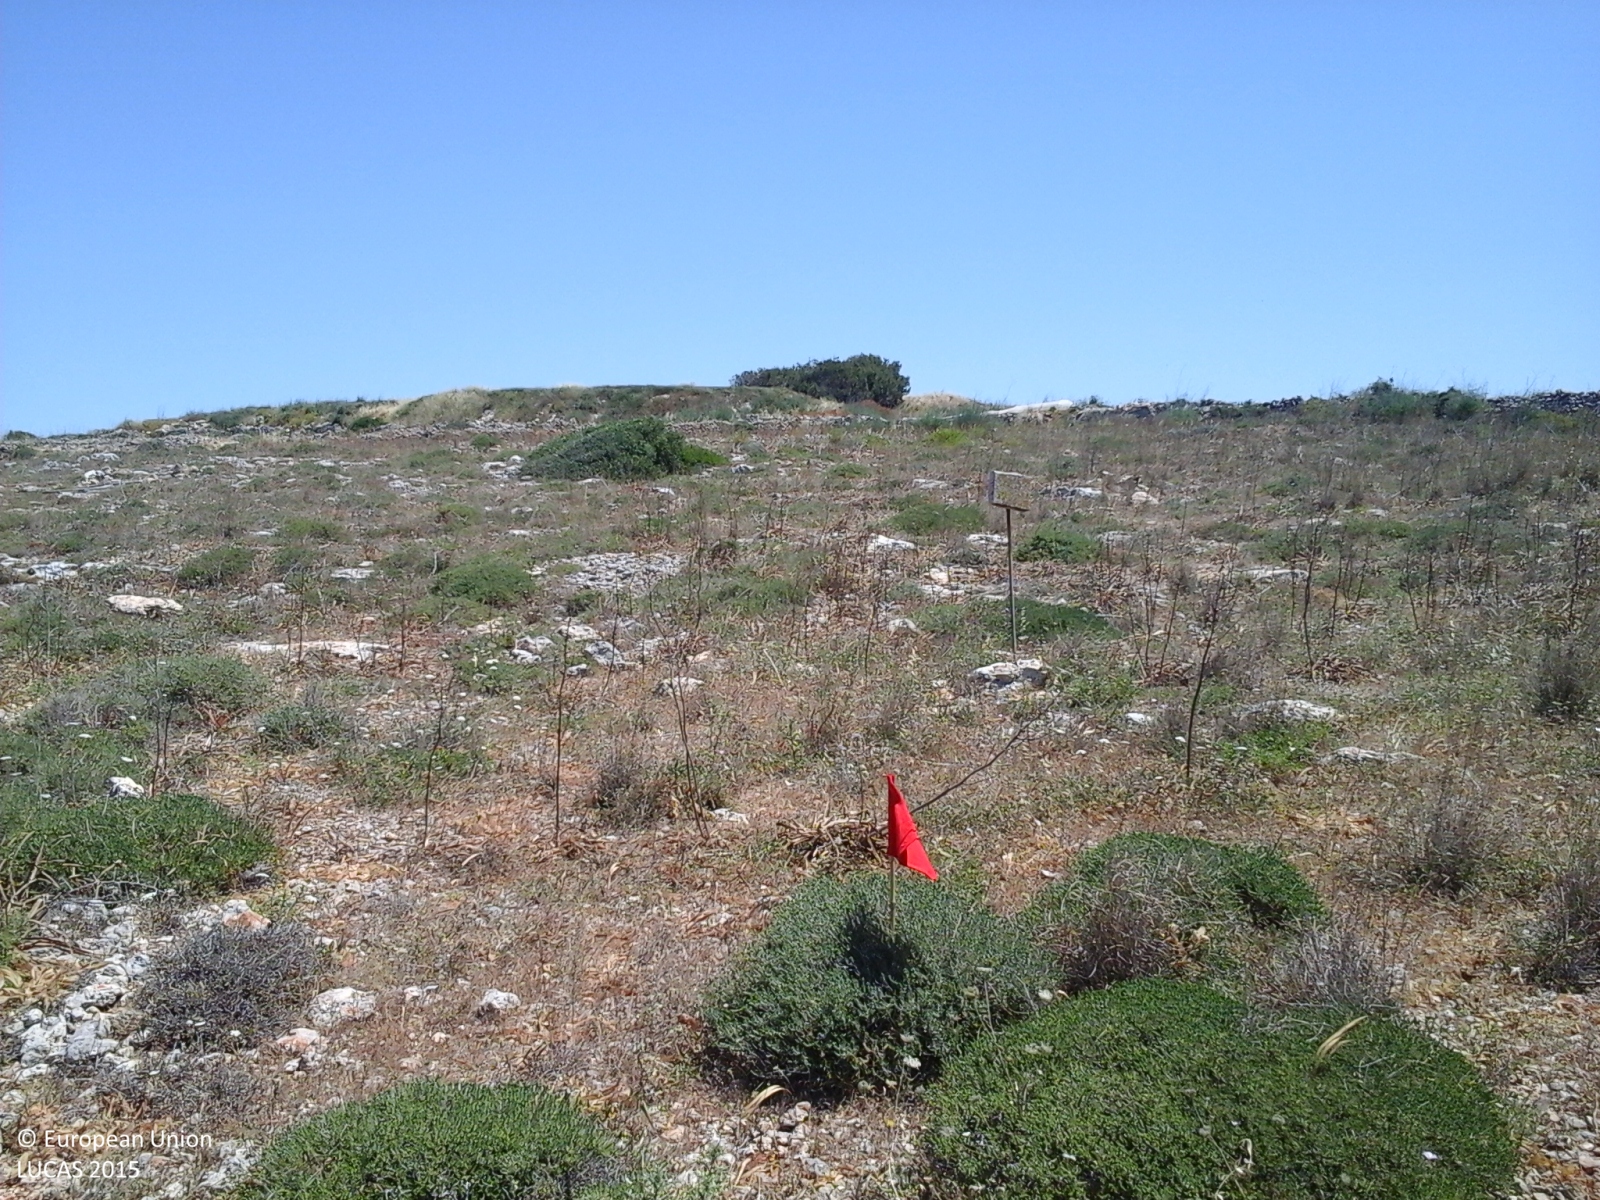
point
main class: Shrubland
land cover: Shrubland without tree cover
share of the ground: > 75 %
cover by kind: shrubs 50 %, herbaceous plants 30 %, consolidated bare surface 20 %
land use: Semi-natural and natural areas not in use
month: May
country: MT
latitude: 35.8826
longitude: 14.3571
